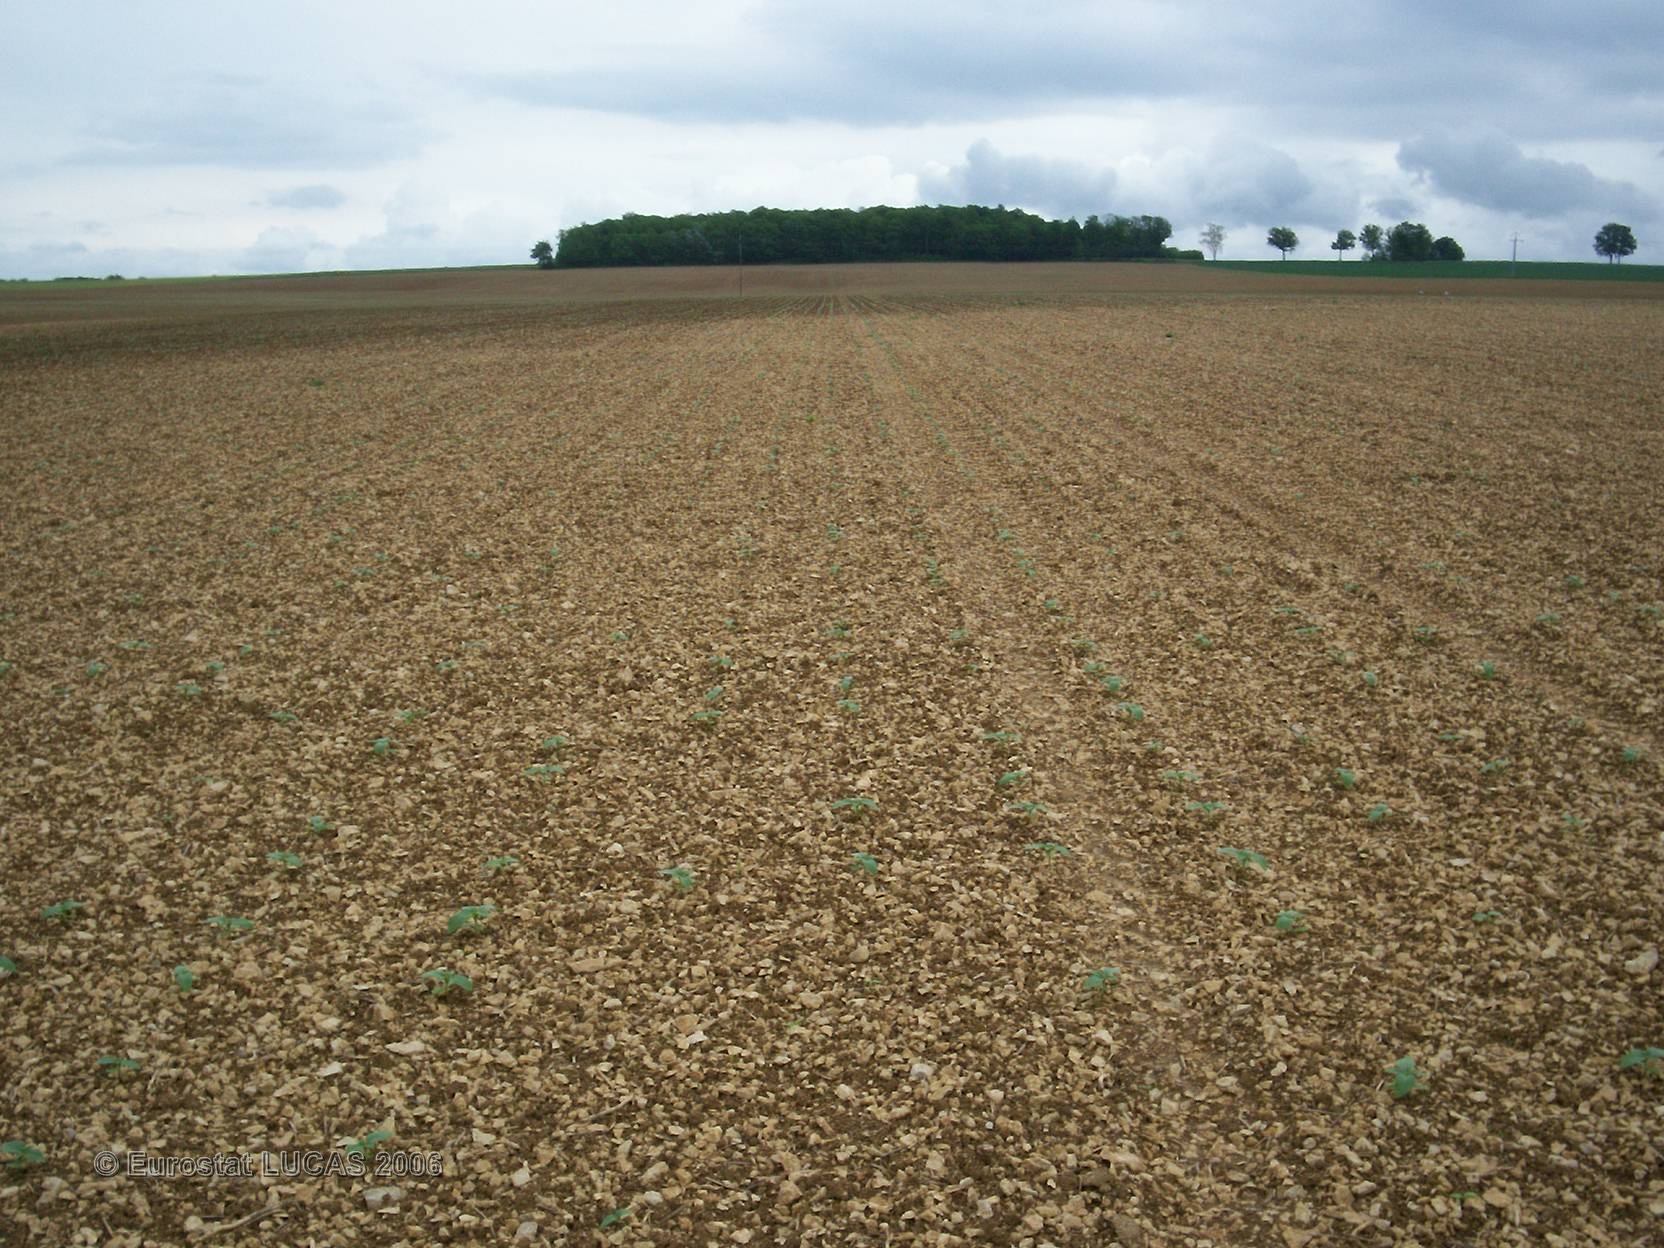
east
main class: Cropland
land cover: Sunflower
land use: Agriculture (excluding fallow land and kitchen gardens)
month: May
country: FR
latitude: 48.2109
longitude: 4.4666
